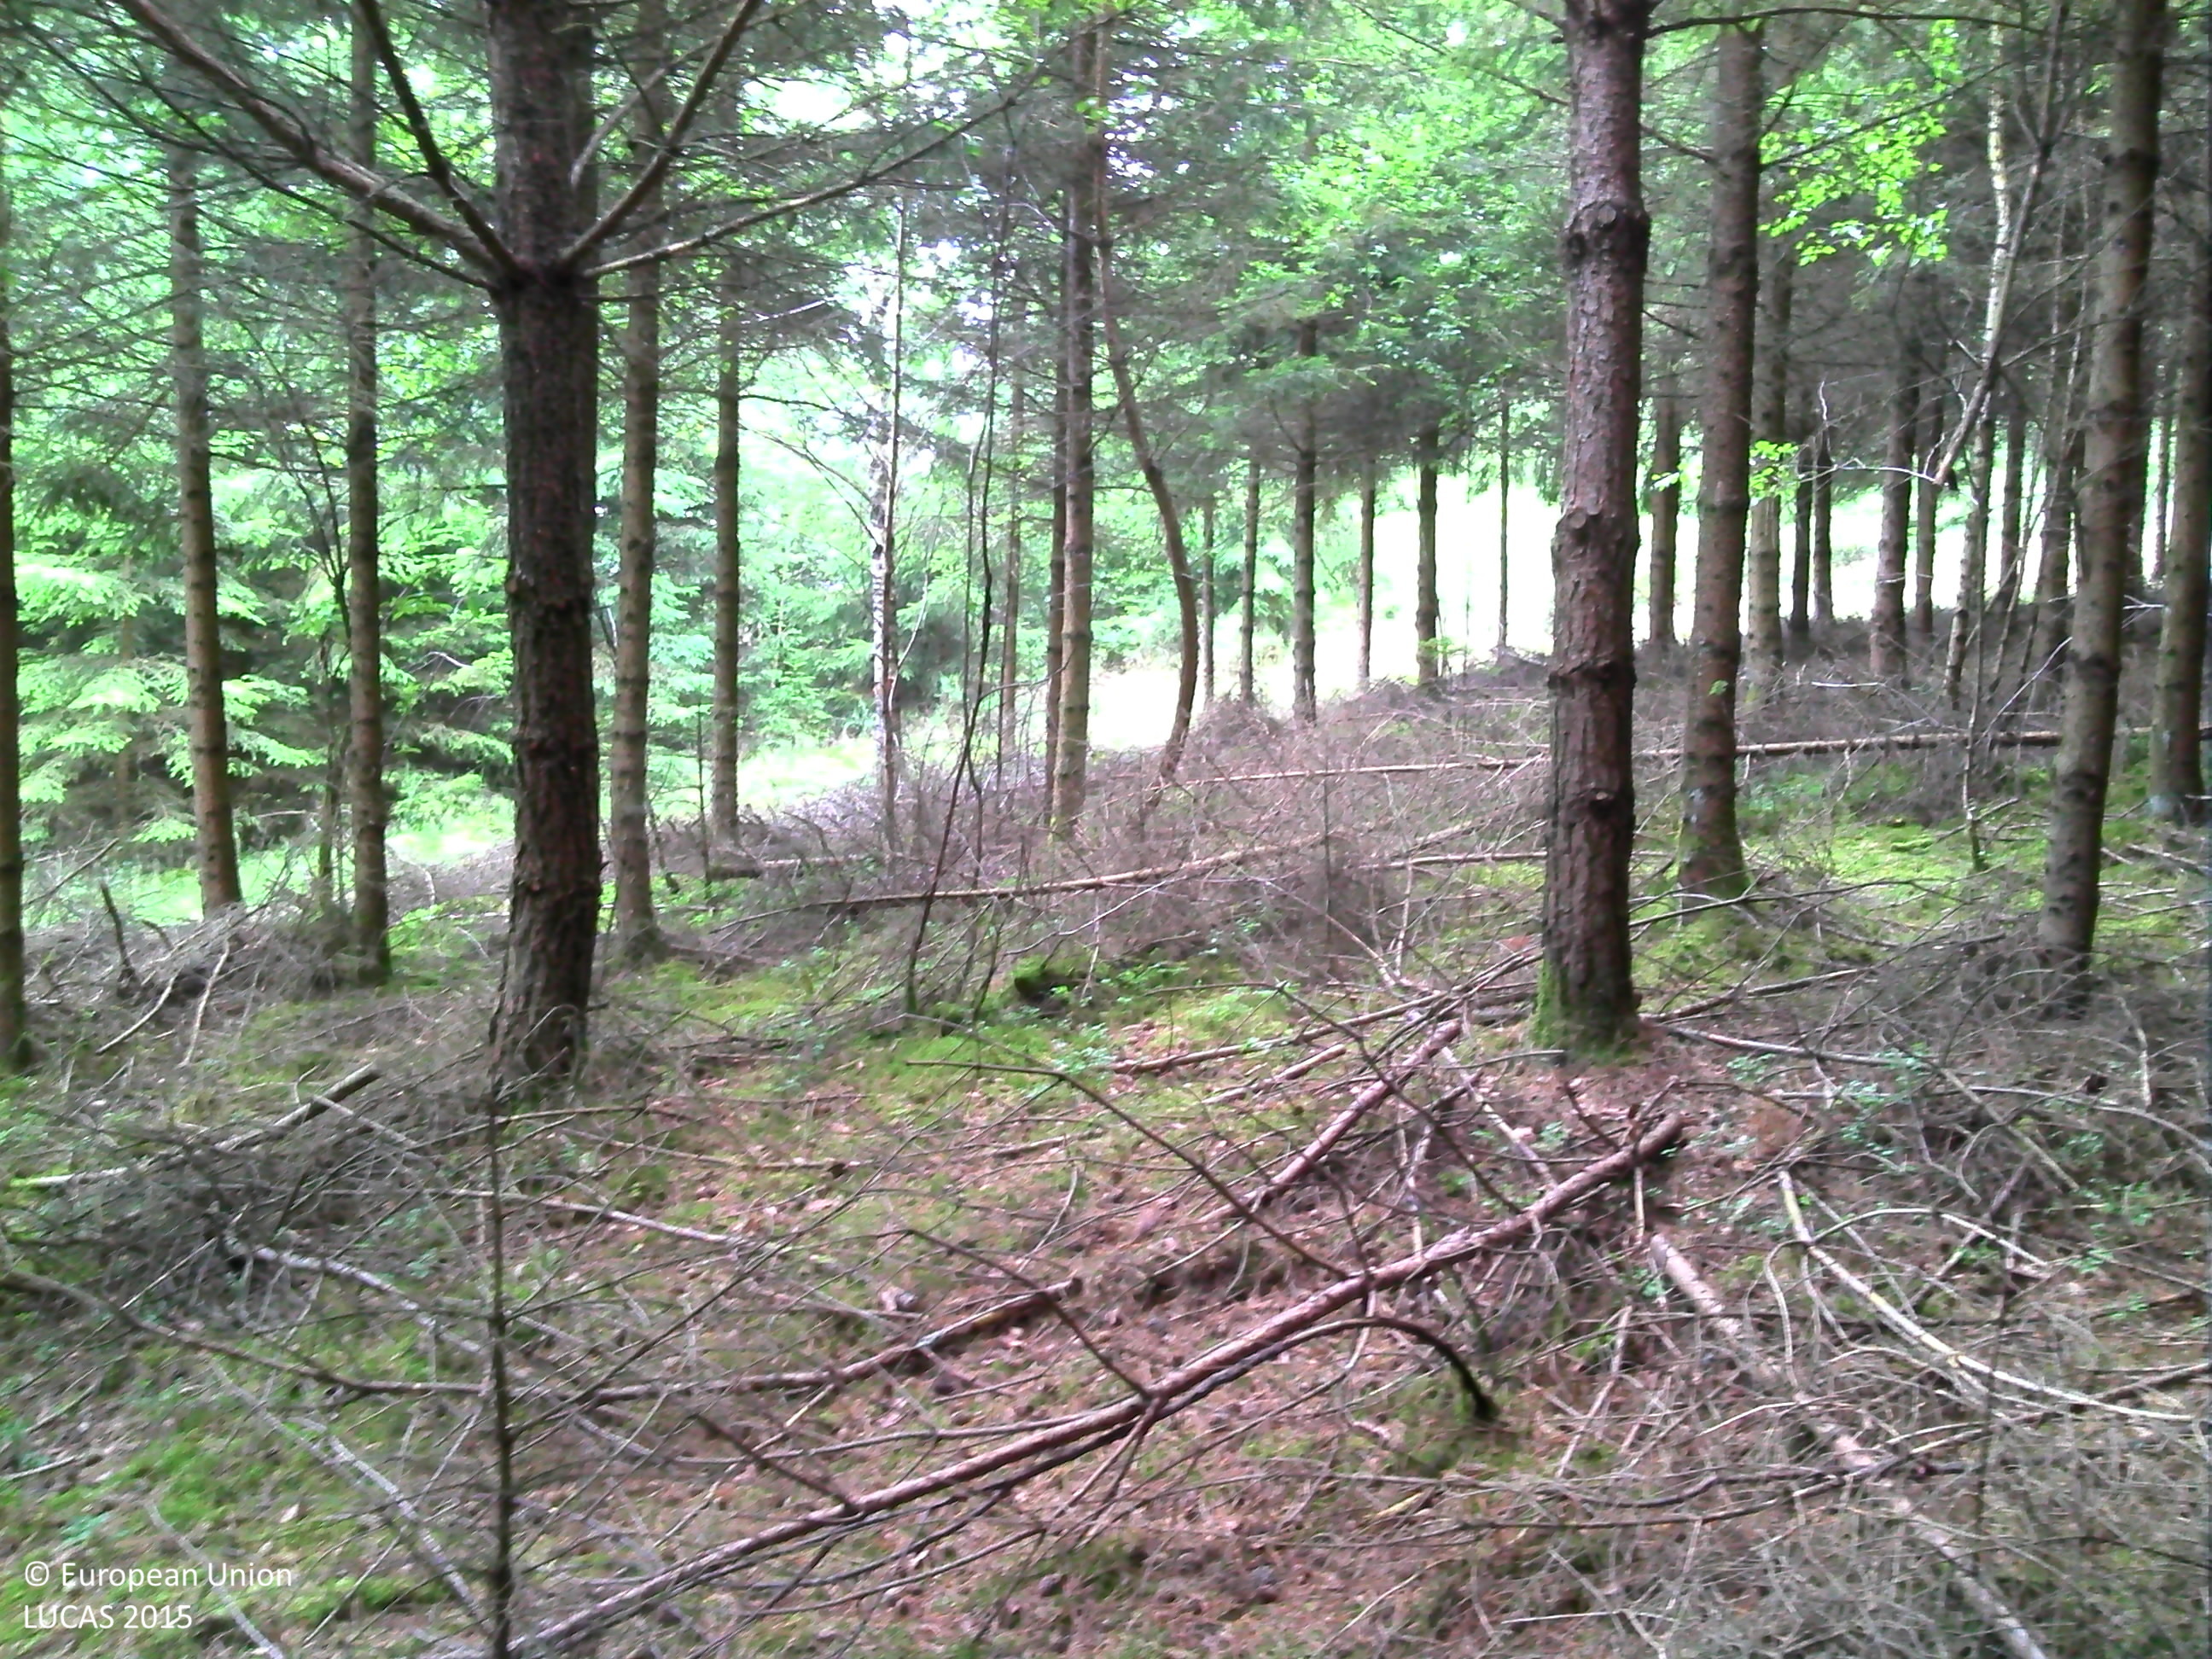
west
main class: Woodland
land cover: Spruce dominated coniferous woodland
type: exotic forest
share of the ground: > 75 %
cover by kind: coniferous forest trees 90 %, lichens and mosses 10 %
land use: Forestry
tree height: > 5 m
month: July
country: BE
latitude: 50.2658
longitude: 6.2256
